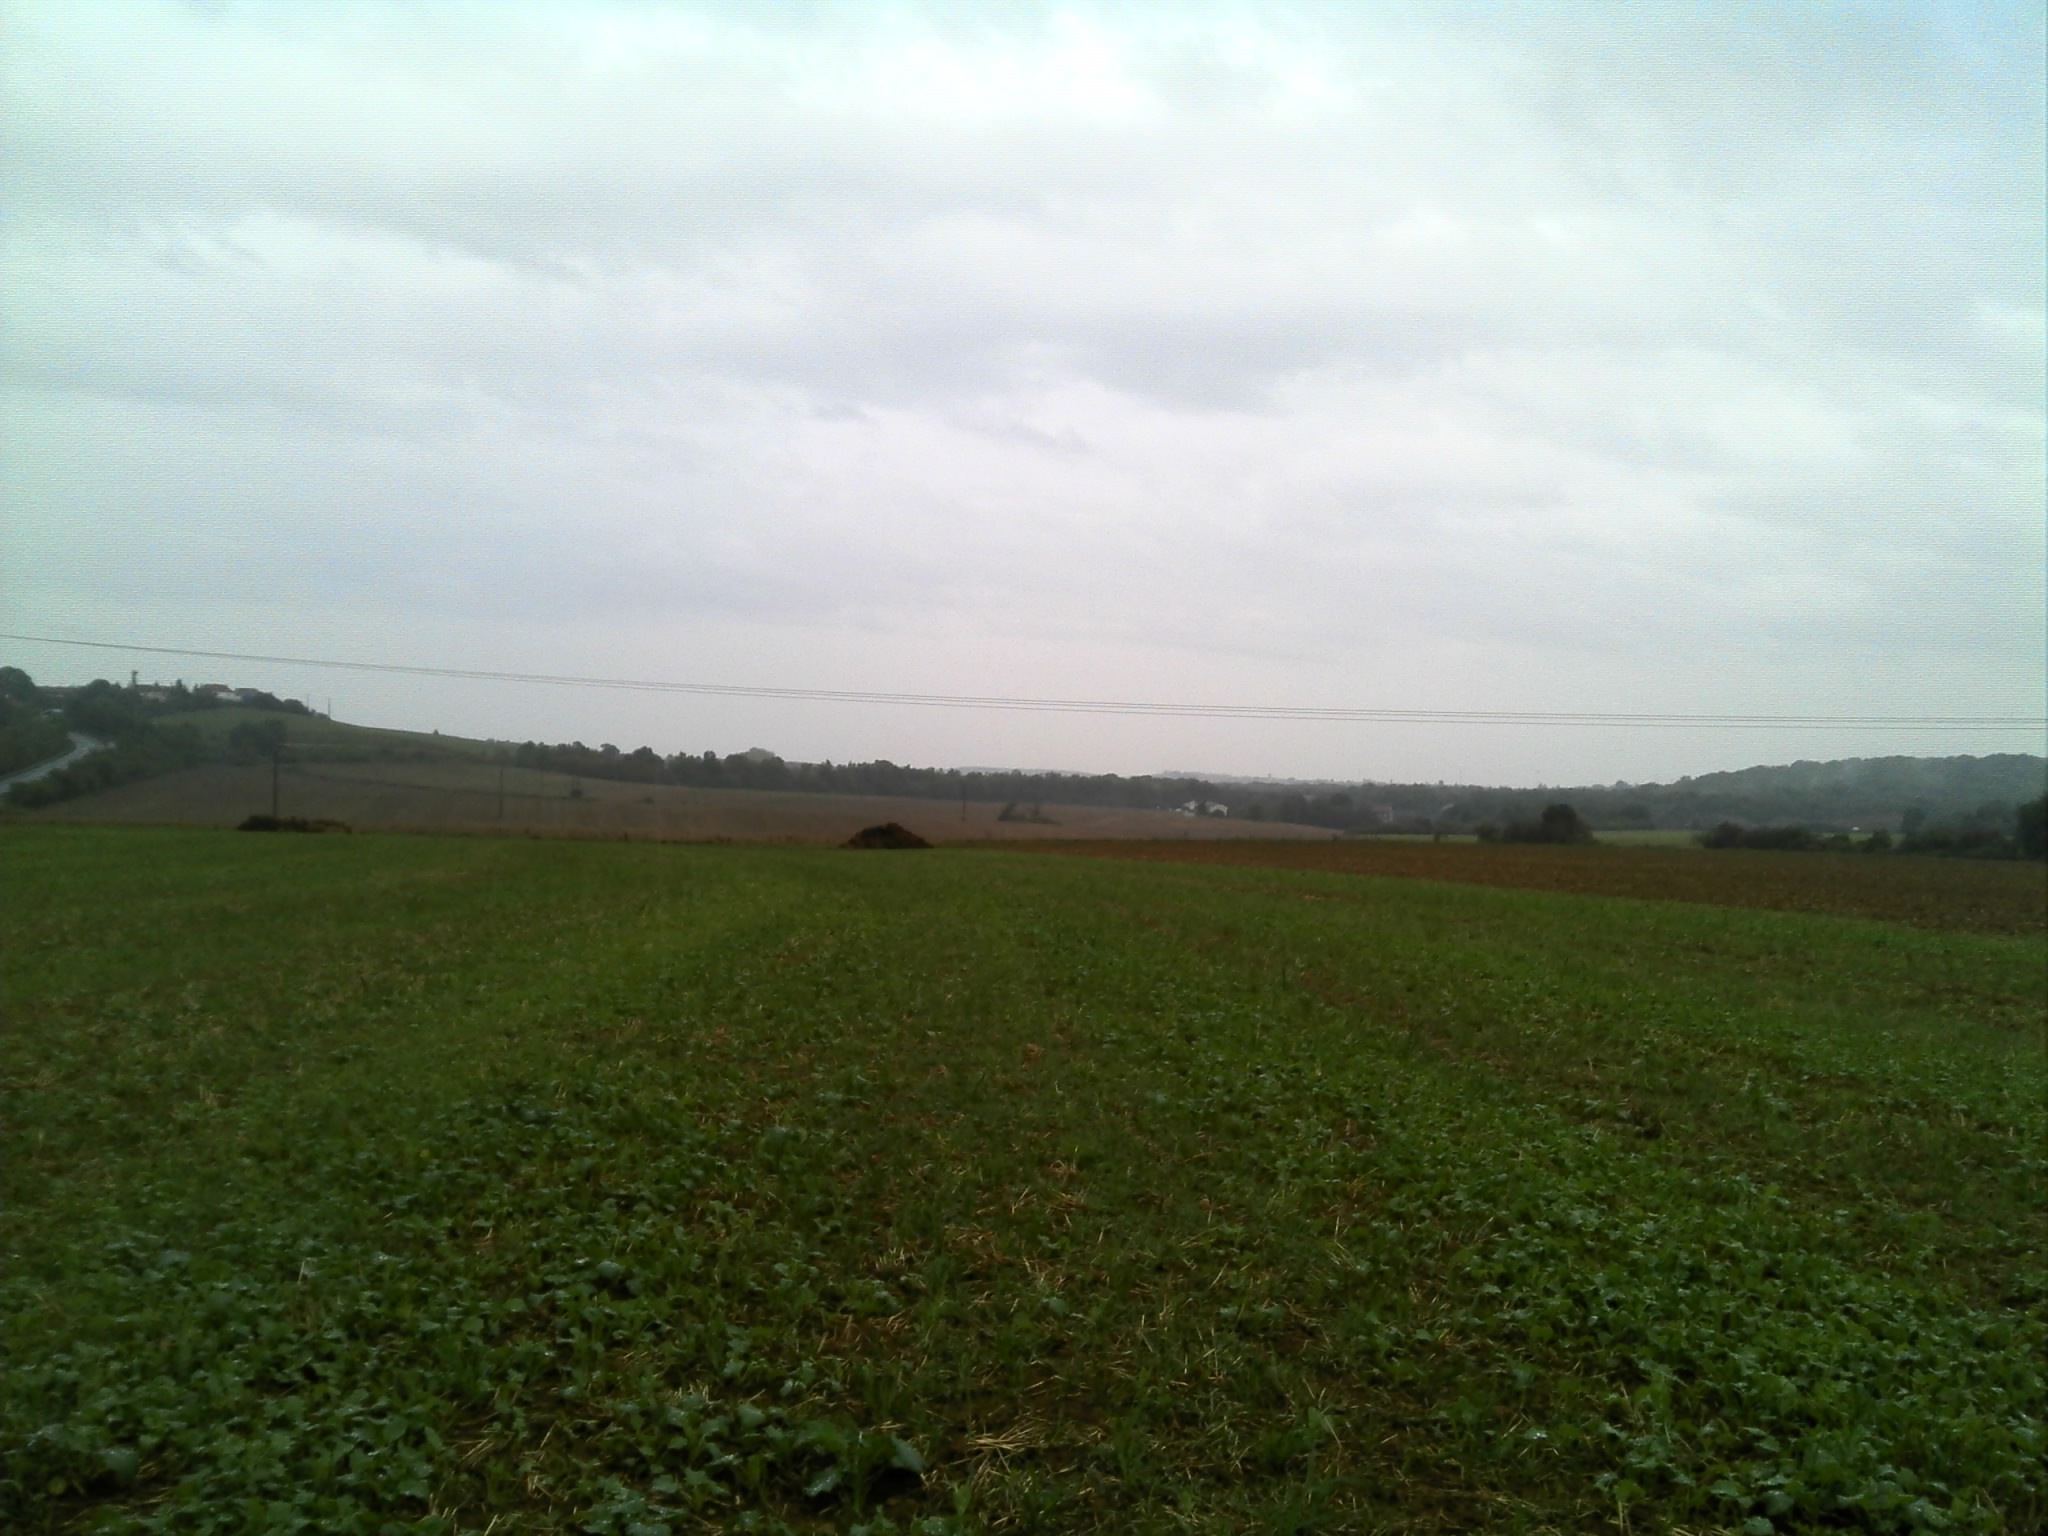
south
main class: Cropland
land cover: Rape and turnip rape
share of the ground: < 10 %
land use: Agriculture (excluding fallow land and kitchen gardens)
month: September
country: FR
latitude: 49.3367
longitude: 5.9119
